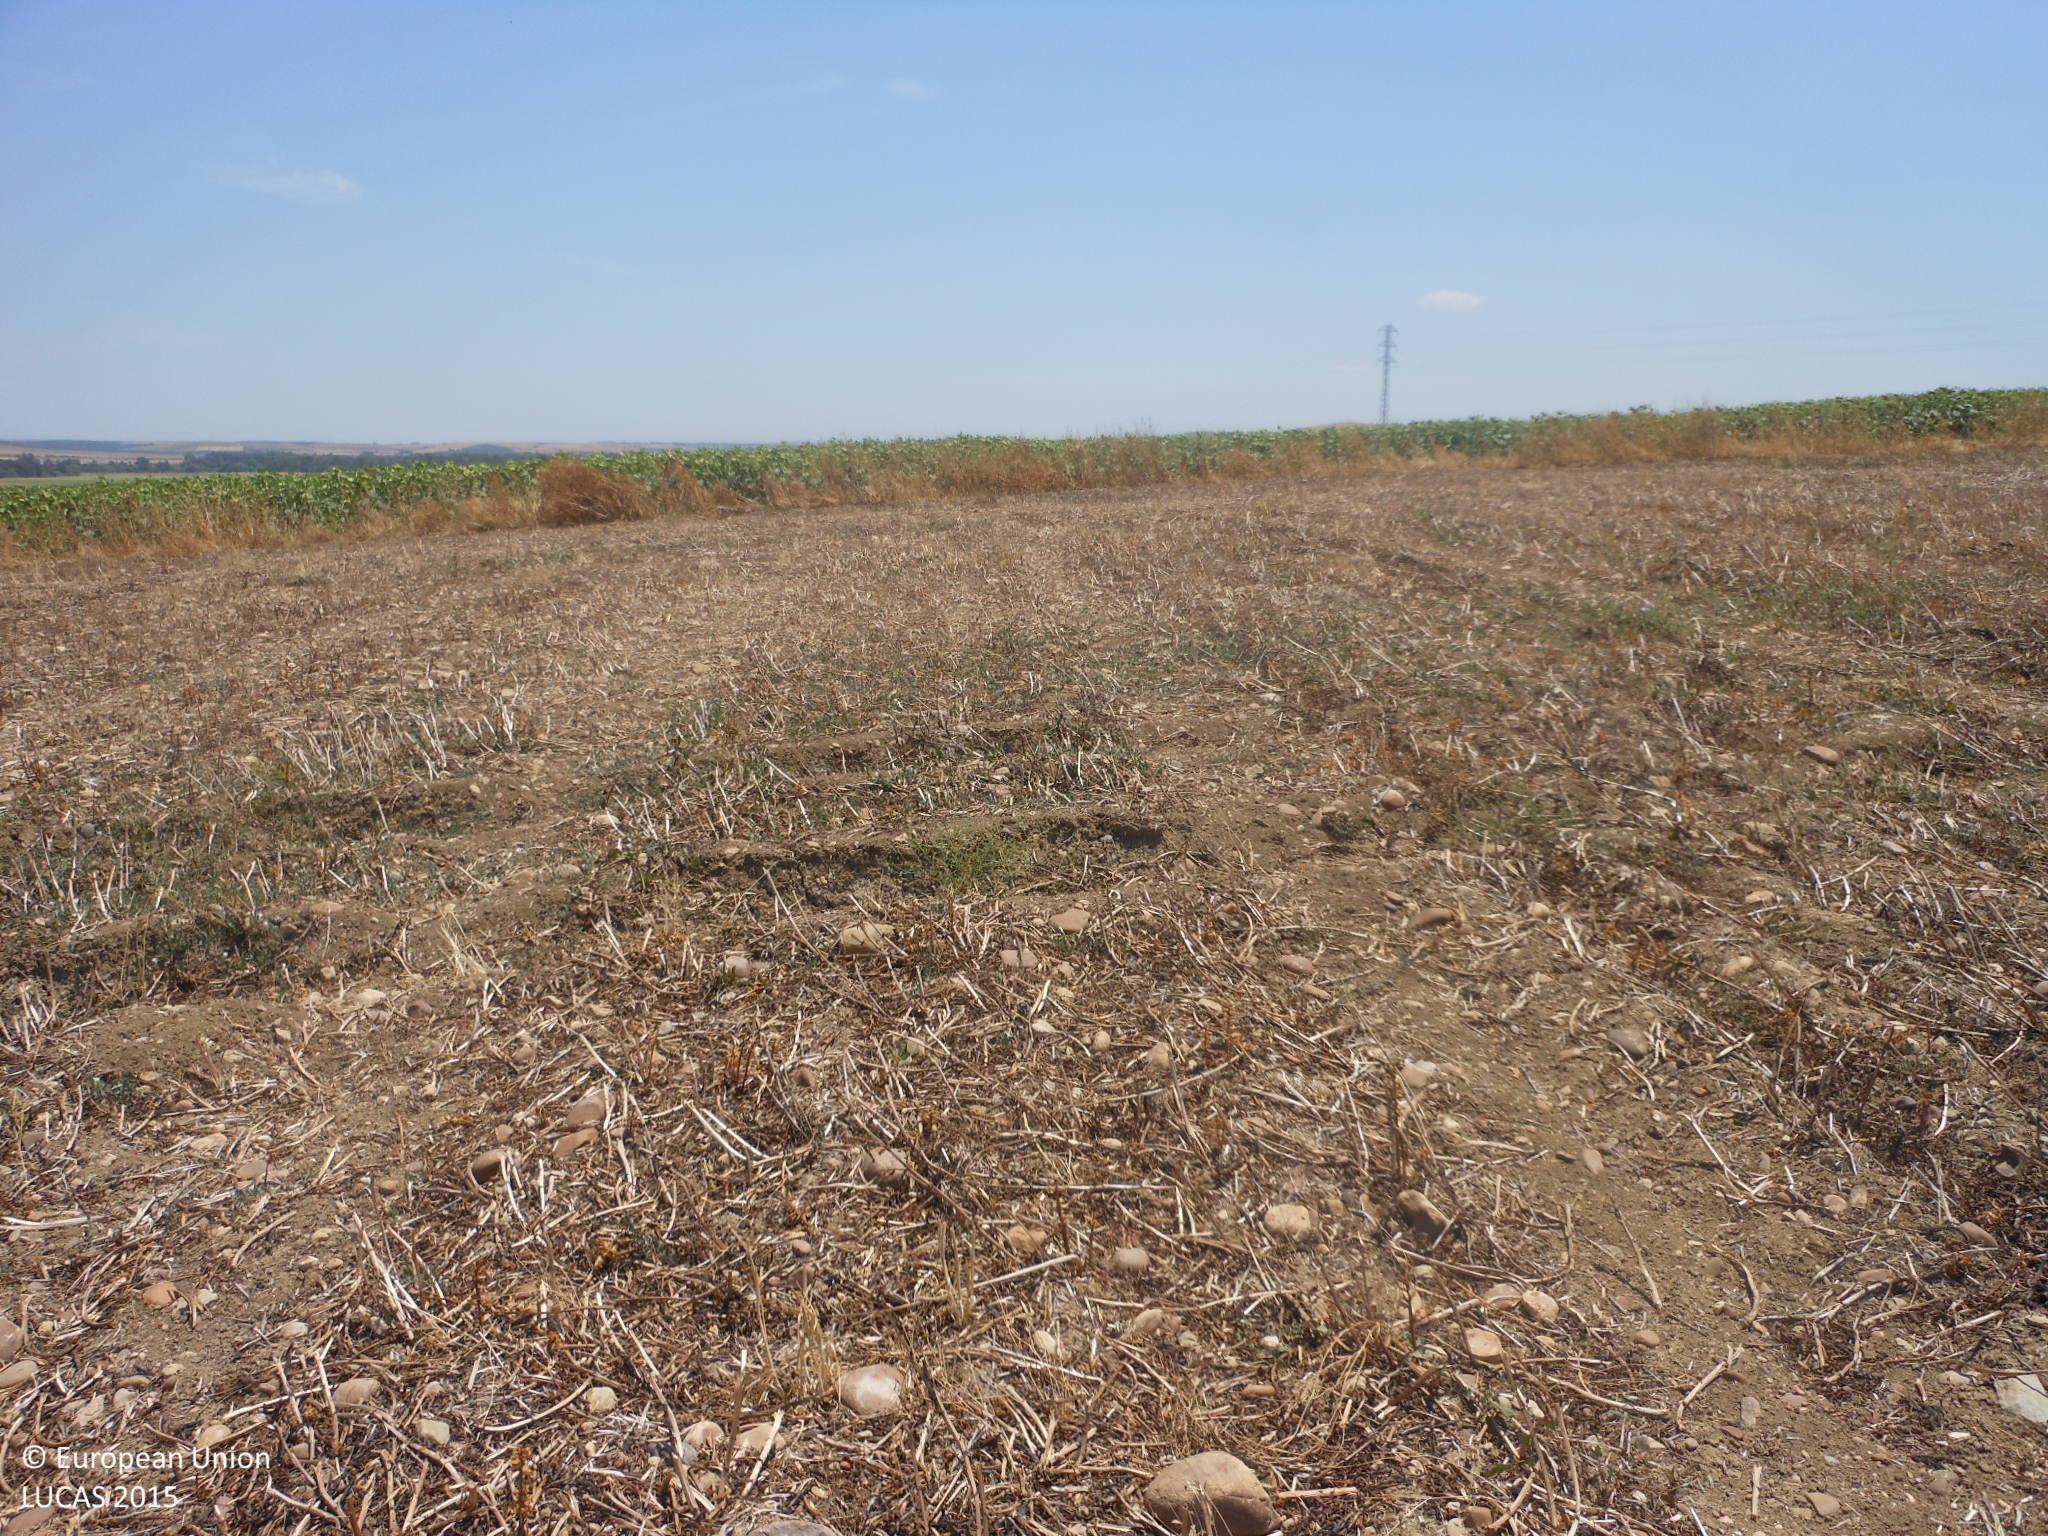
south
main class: Cropland
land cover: Dry pulses
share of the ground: < 10 %
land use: Agriculture (excluding fallow land and kitchen gardens)
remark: Harvested field
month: June
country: ES
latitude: 37.6140
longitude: -5.1386
